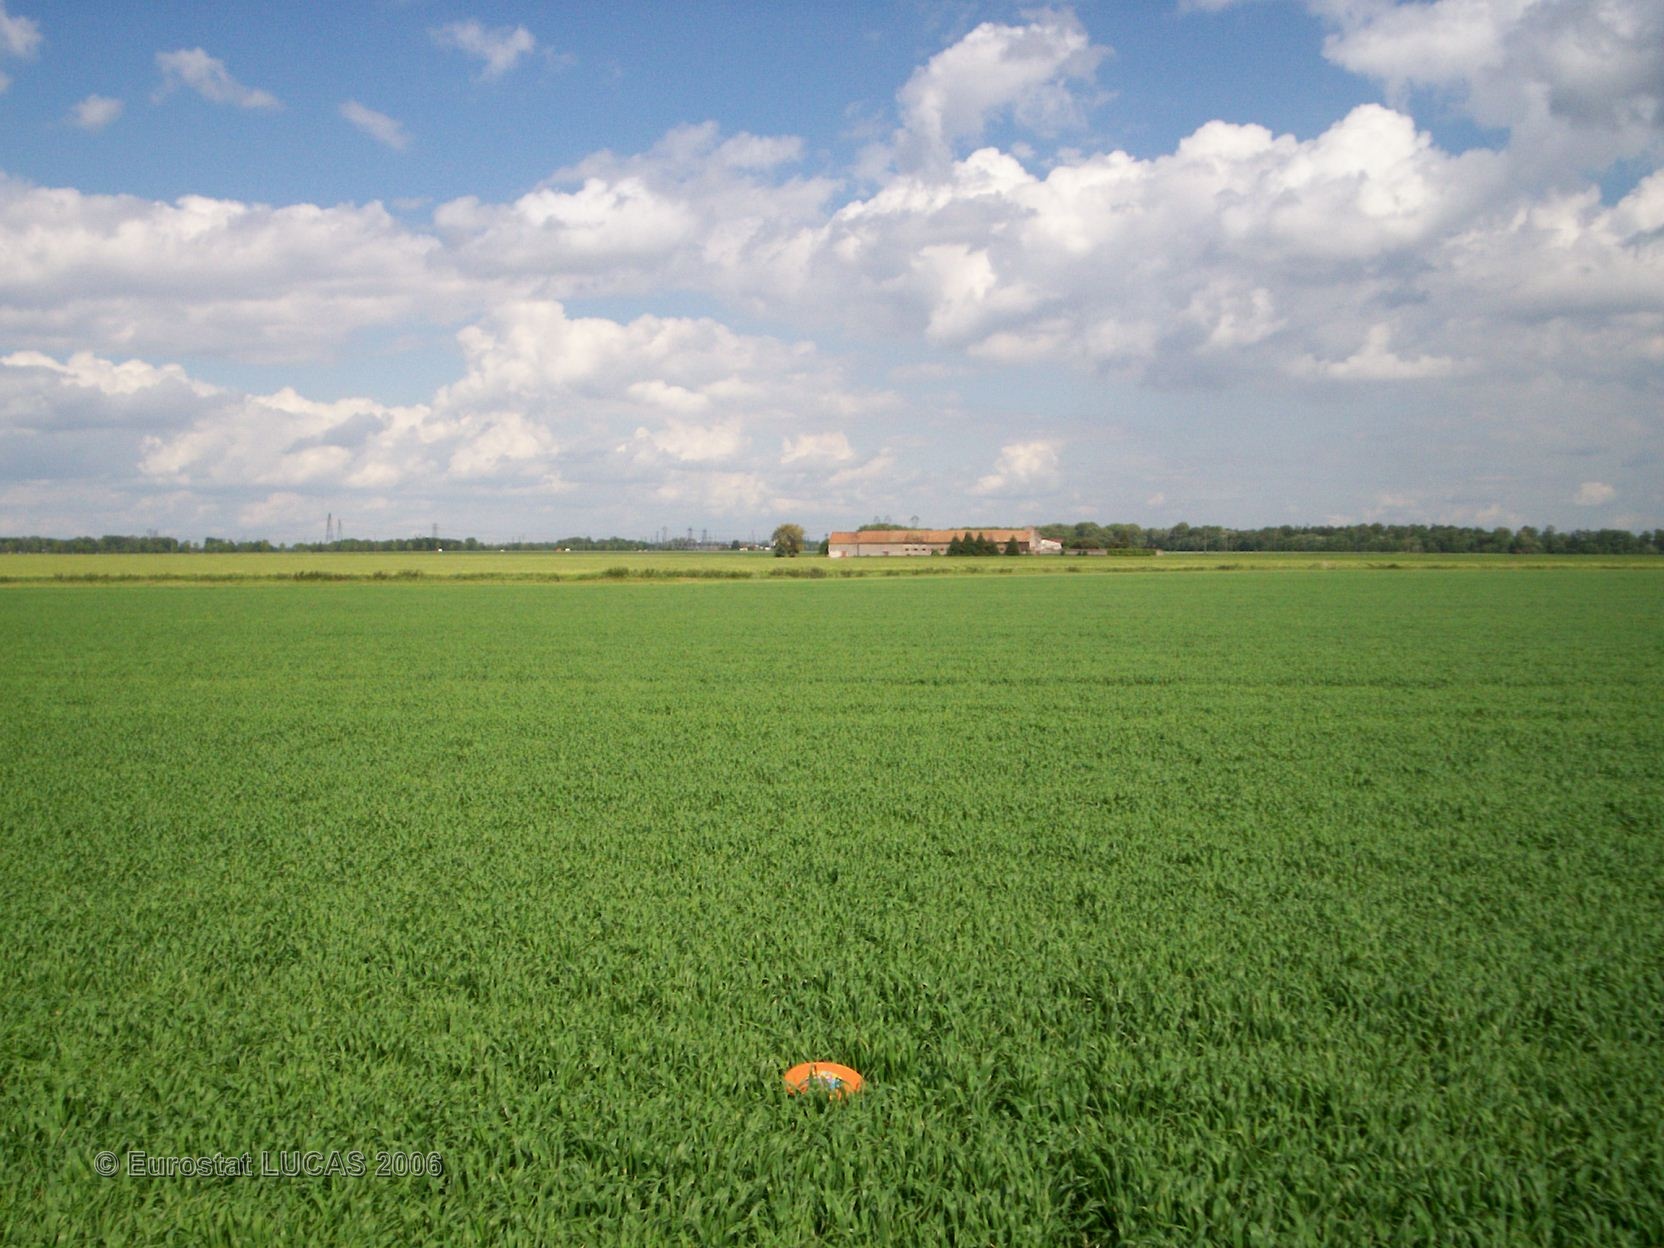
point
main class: Cropland
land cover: Barley
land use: Agriculture (excluding fallow land and kitchen gardens)
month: May
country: FR
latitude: 48.5443
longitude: 2.7437
